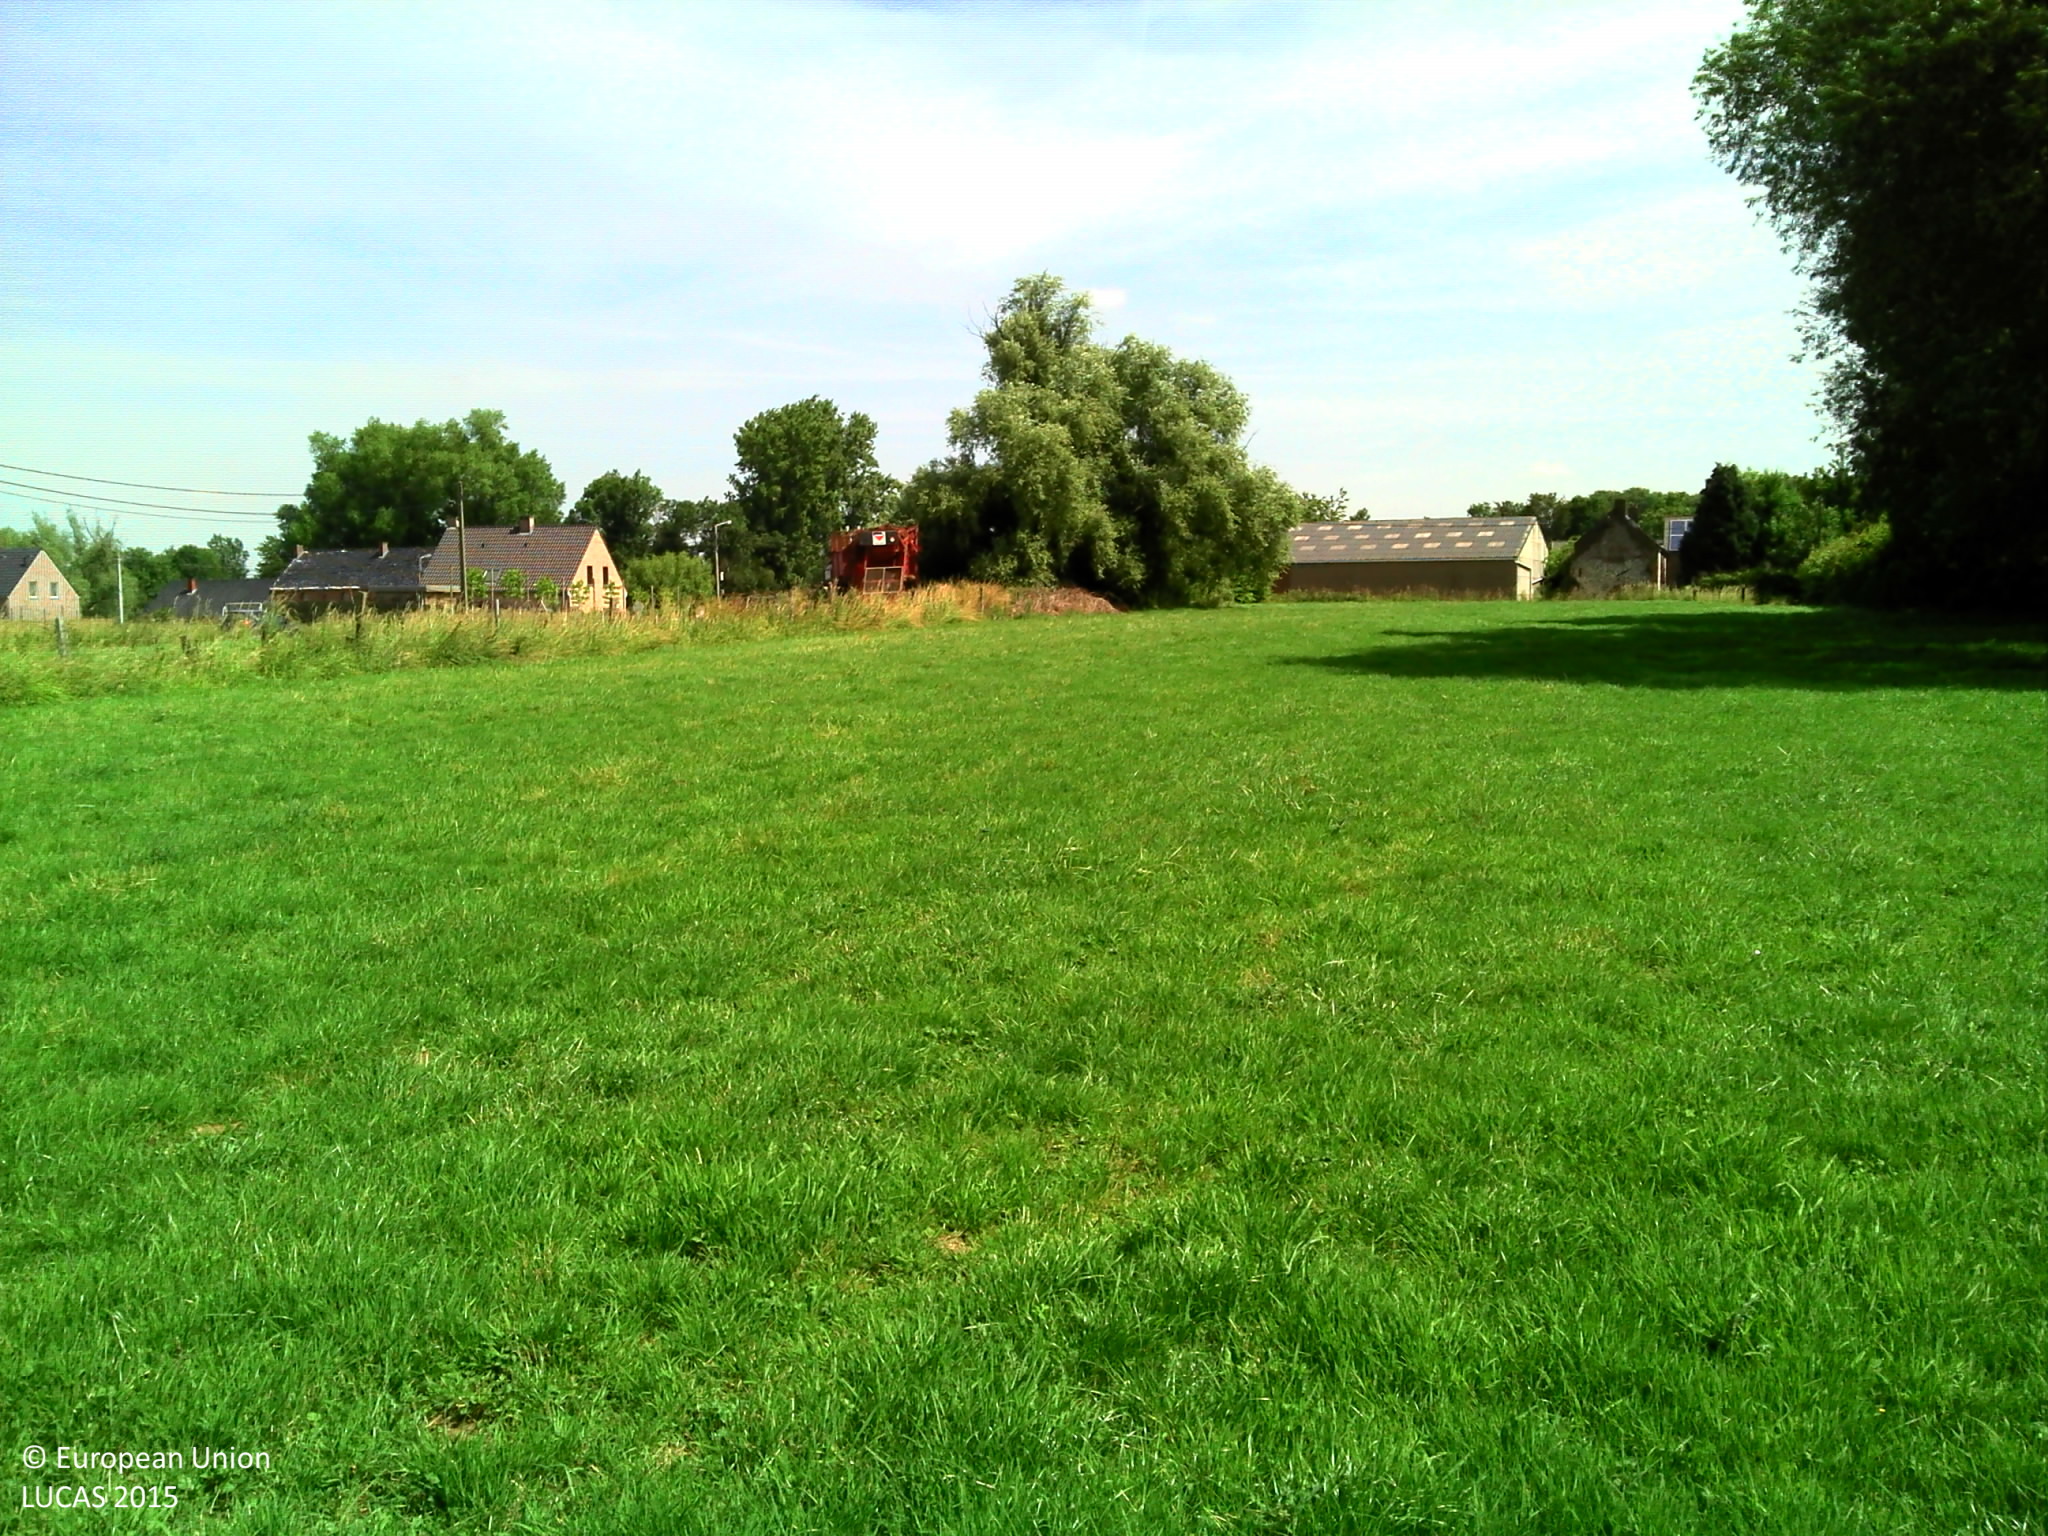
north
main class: Grassland
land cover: Grassland without tree/shrub cover
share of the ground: > 75 %
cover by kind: herbaceous plants 100 %
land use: Agriculture (excluding fallow land and kitchen gardens)
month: June
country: BE
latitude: 50.5456
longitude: 3.6000
